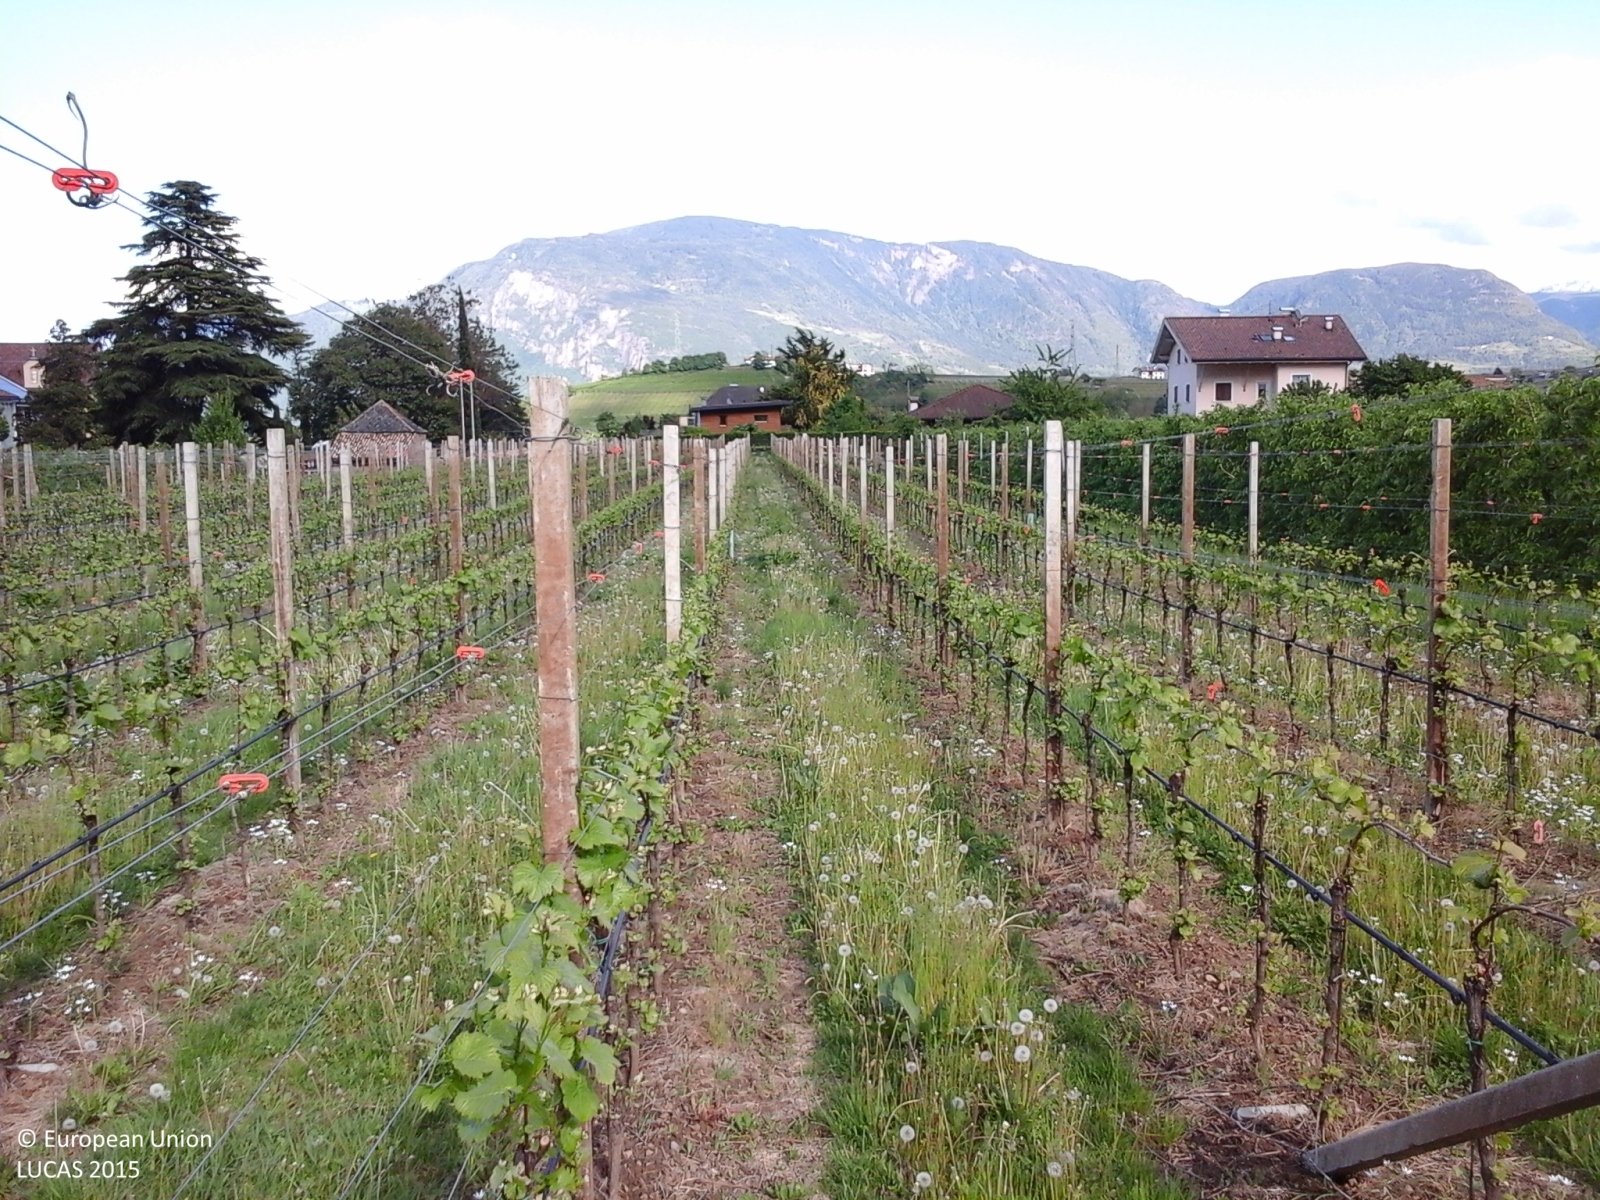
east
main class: Cropland
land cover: Vineyards
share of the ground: 50 - 75 %
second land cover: Grassland without tree/shrub cover
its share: 50 - 75 %
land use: Agriculture (excluding fallow land and kitchen gardens)
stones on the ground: < 10 %
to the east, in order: Vineyards; Grassland without tree/shrub cover; Fences; Paved roads, cycling and walking lanes; Other bare soil; Grassland without tree/shrub cover; Vineyards; Grassland without tree/shrub cover; Vineyards; Grassland without tree/shrub cover
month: April
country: IT
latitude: 46.4699
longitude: 11.2617
